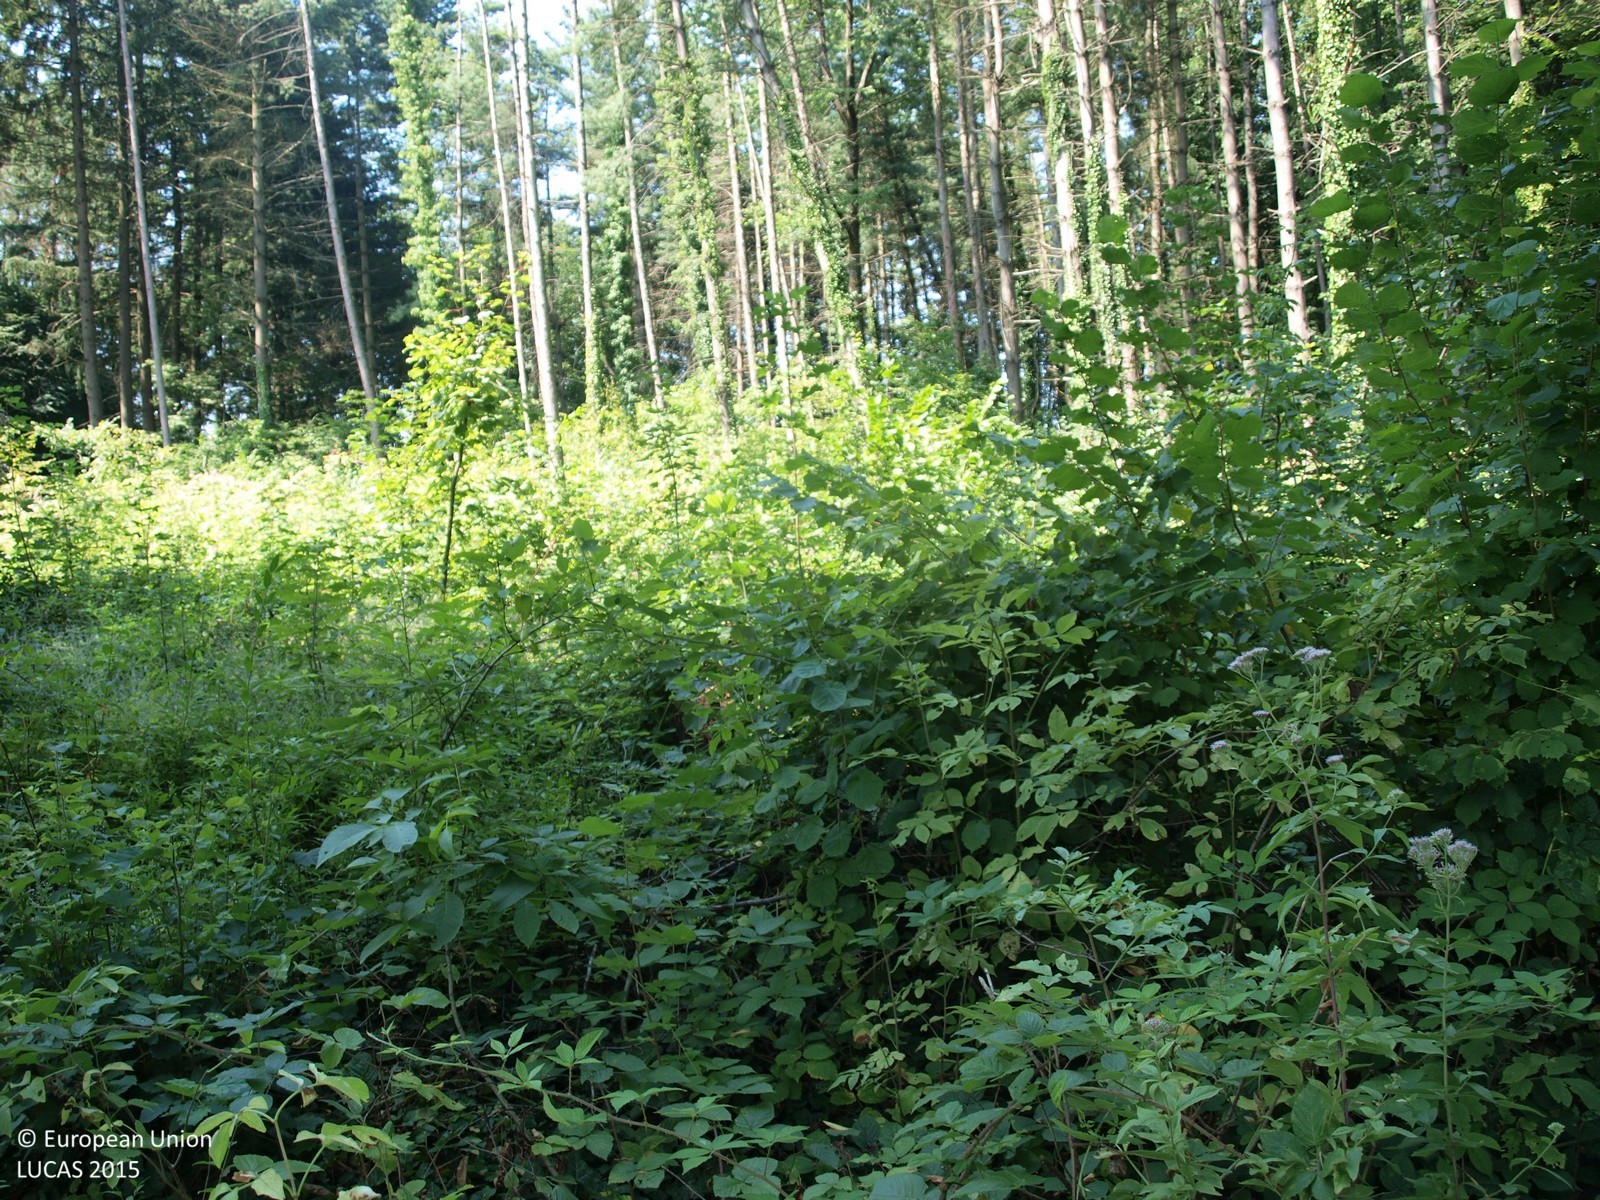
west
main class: Woodland
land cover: Broadleaved woodland
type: mesophytic deciduous forest
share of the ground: > 75 %
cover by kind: broadleaved forest trees 100 %
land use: Forestry
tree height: > 5 m
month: August
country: HR
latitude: 46.0255
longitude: 16.5236
